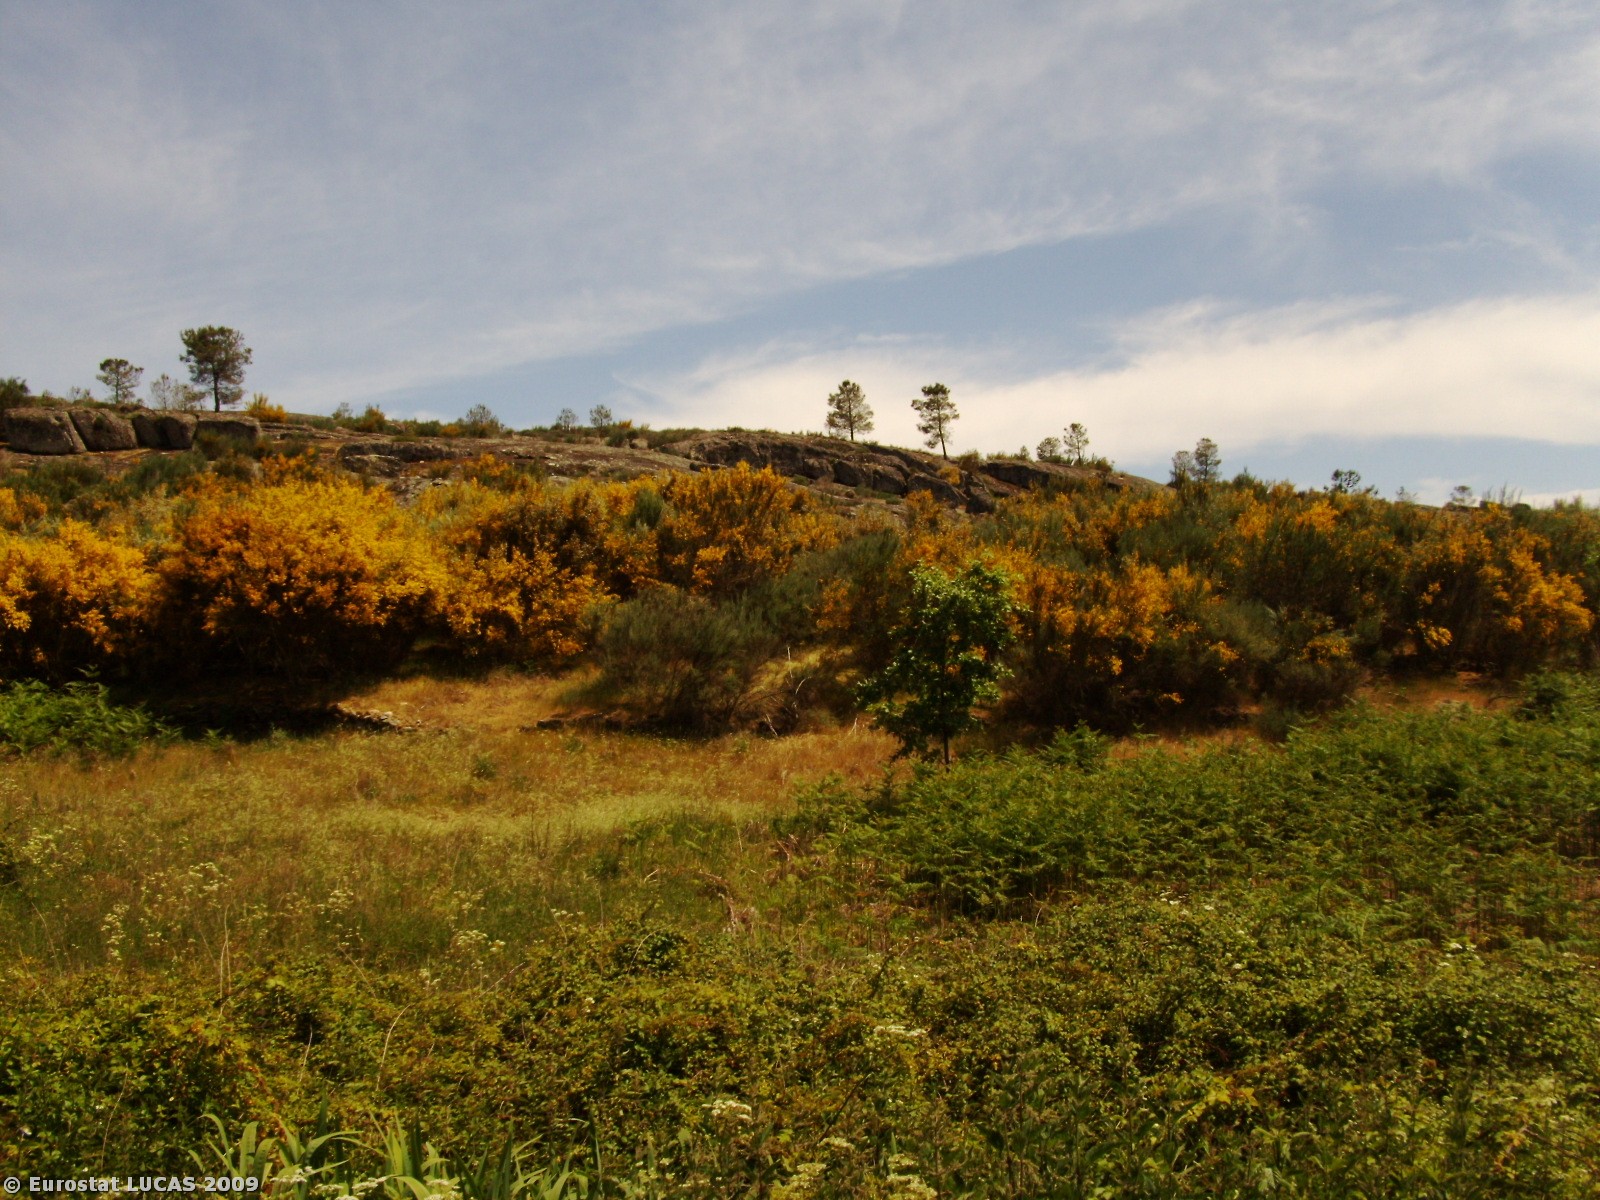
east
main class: Shrubland
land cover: Shrubland without tree cover
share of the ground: > 75 %
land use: Fallow land
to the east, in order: Shrubland without tree cover; Bare land
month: May
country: PT
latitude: 40.7804
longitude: -7.5228
